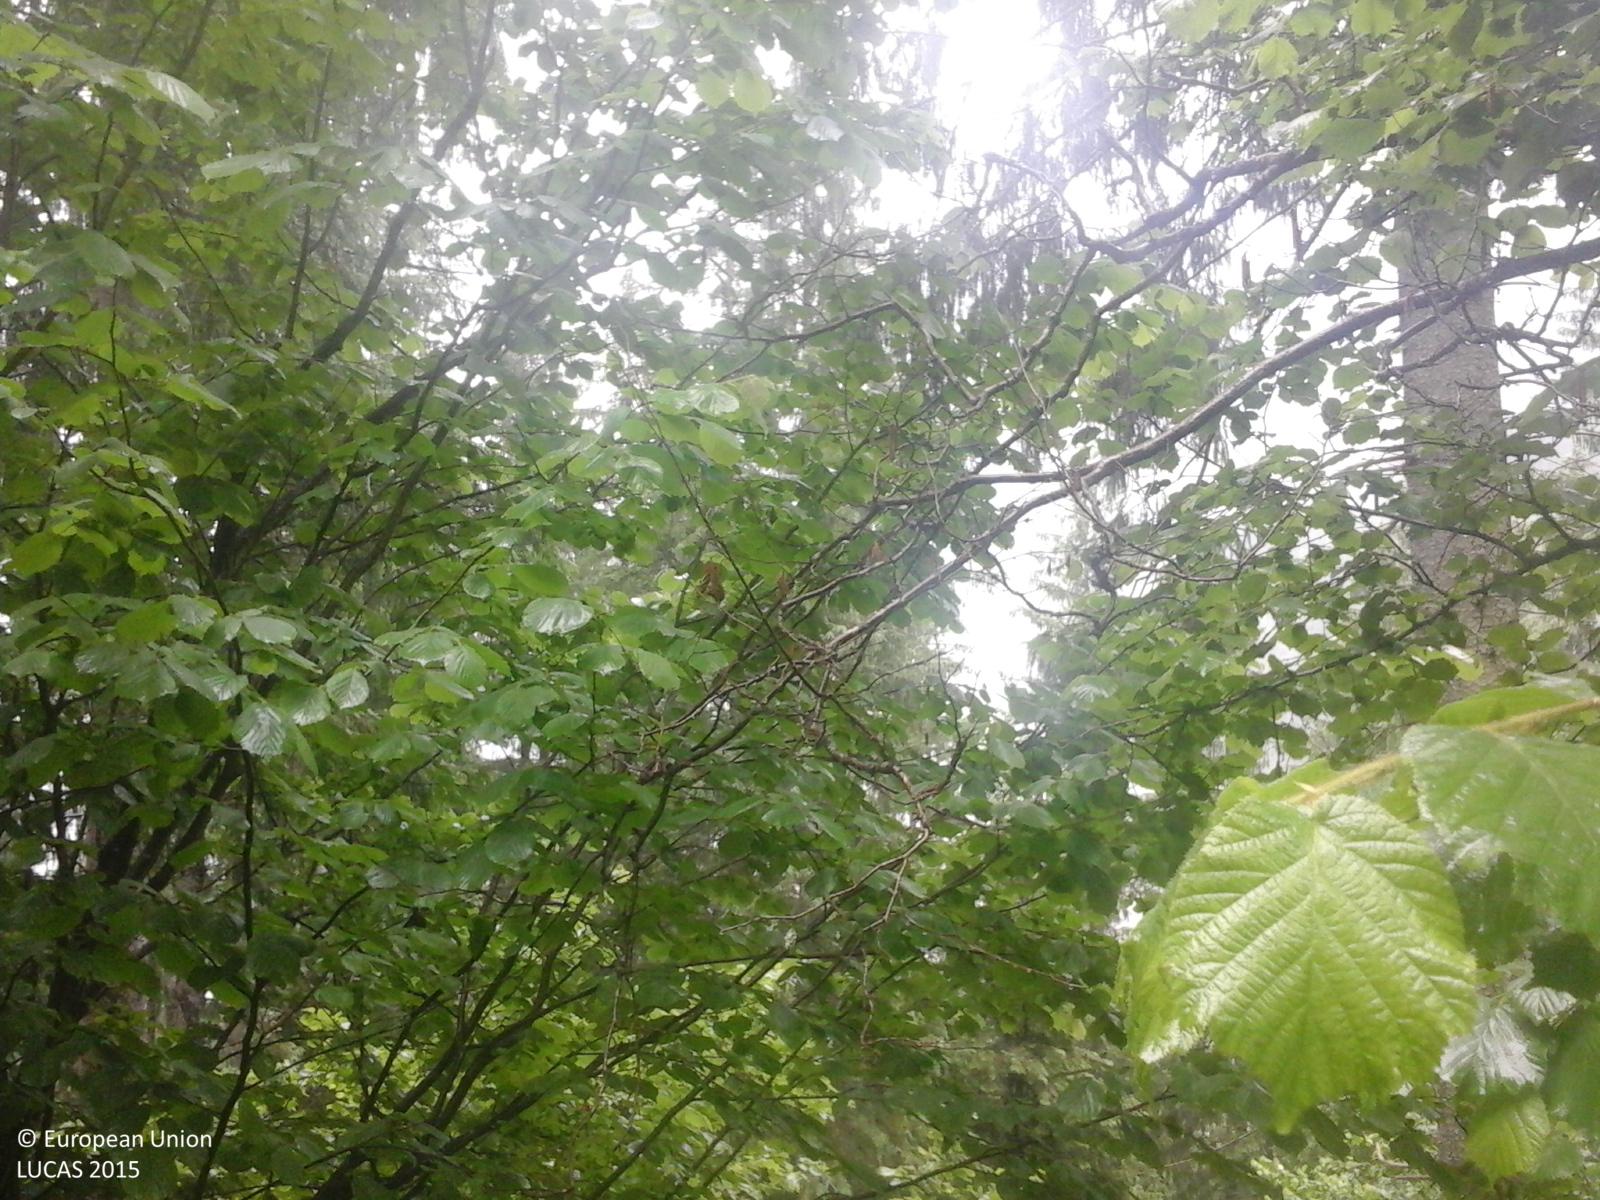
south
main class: Woodland
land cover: Broadleaved woodland
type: beech forest
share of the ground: > 75 %
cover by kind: broadleaved forest trees 90 %, shrubs 5 %, herbaceous plants 5 %
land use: Forestry
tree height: > 5 m
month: June
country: RO
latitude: 47.3399
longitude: 25.6161
